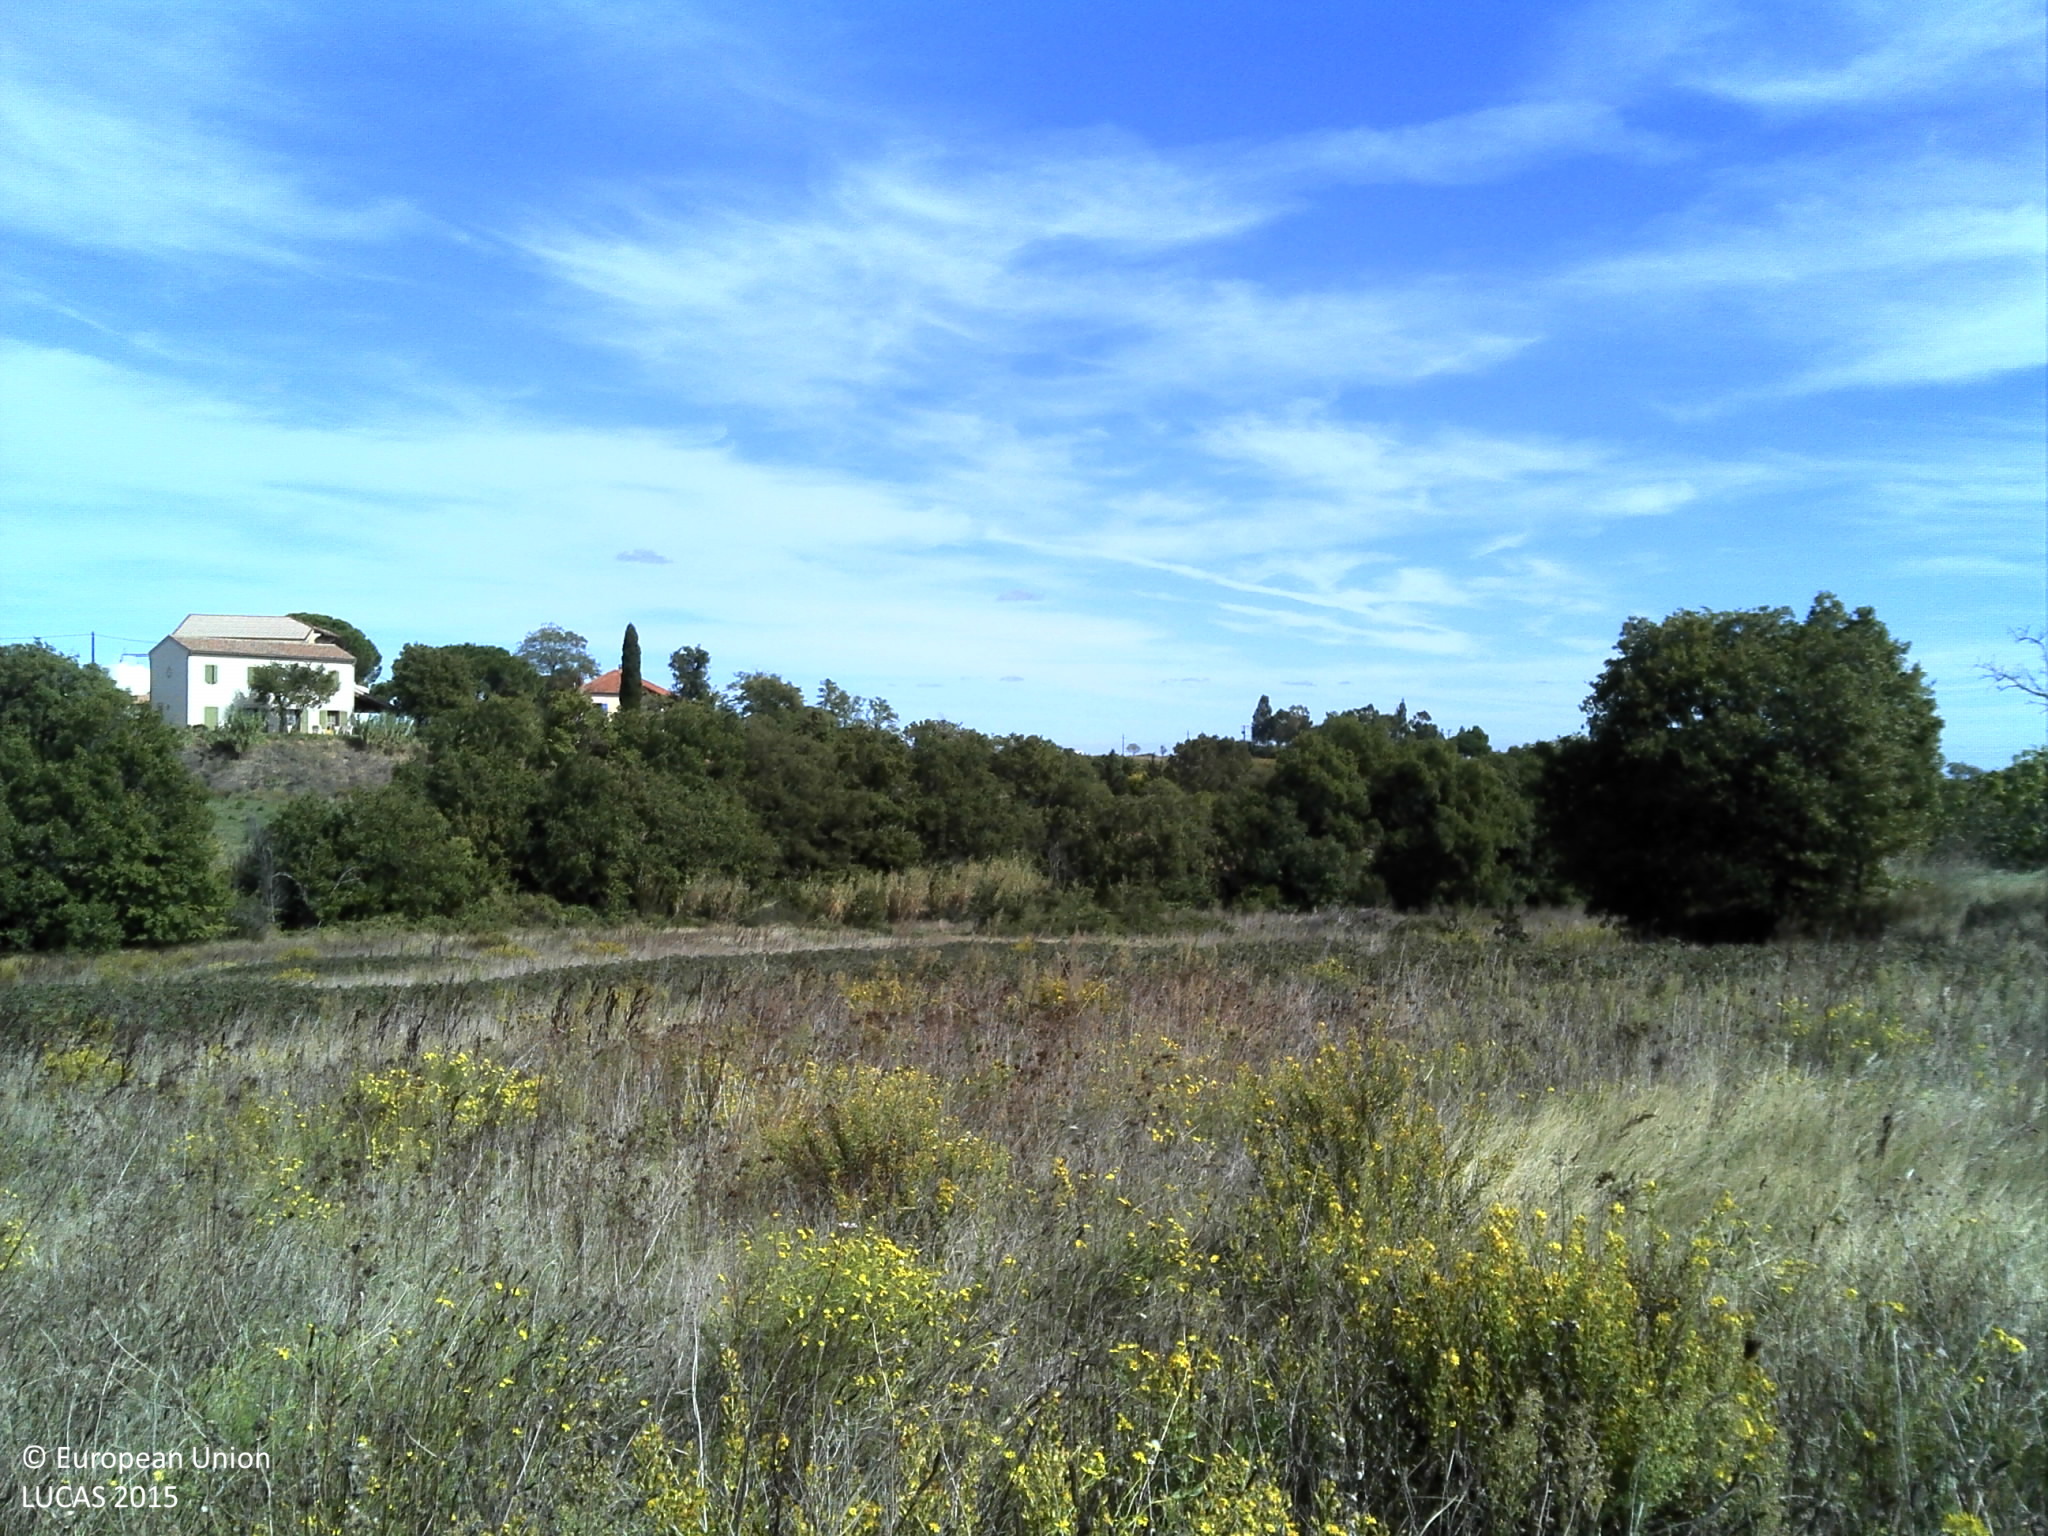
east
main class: Grassland
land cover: Spontaneously vegetated surfaces
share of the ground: > 75 %
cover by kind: herbaceous plants 95 %, shrubs 5 %
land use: Semi-natural and natural areas not in use
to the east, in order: Spontaneously vegetated surfaces; Shrubland without tree cover; Broadleaved woodland; Grassland without tree/shrub cover; Shrubland without tree cover; Grassland without tree/shrub cover; Broadleaved woodland; Rivers and streams; Broadleaved woodland; Arable land (only in case pi)
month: October
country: FR
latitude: 43.3858
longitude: 3.2075
